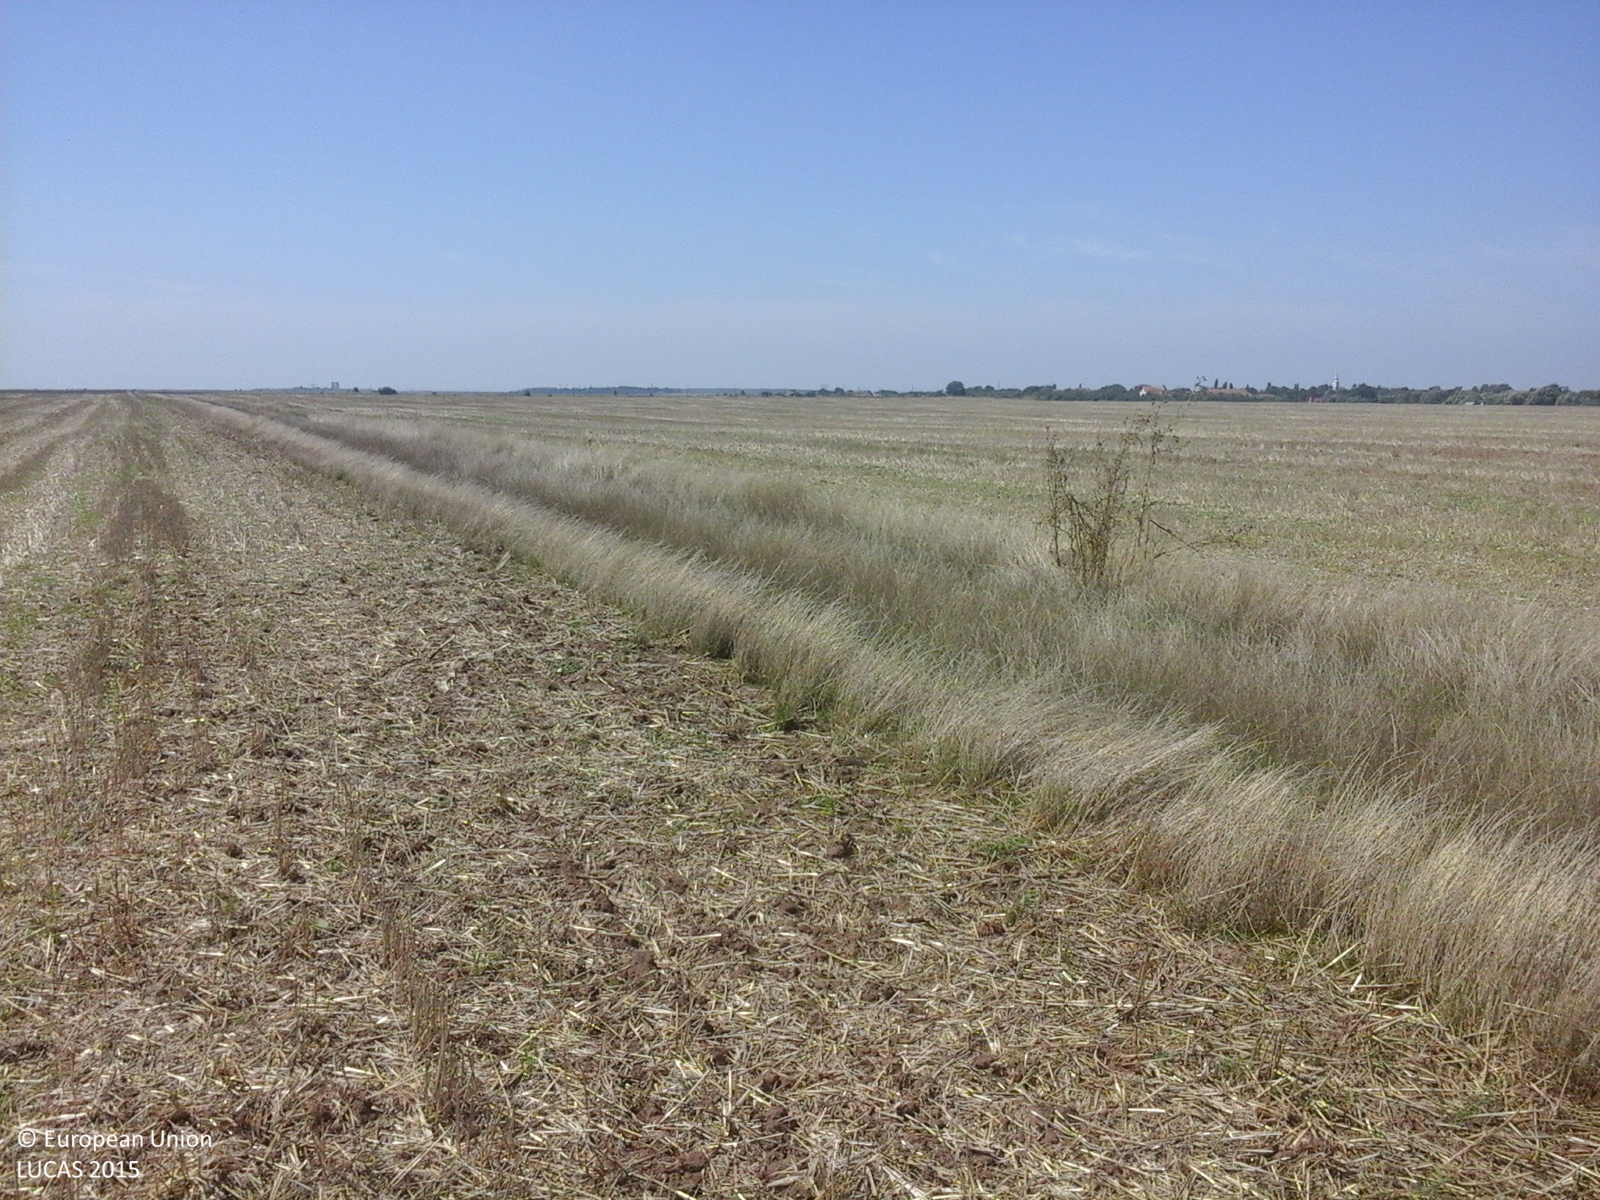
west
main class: Cropland
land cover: Common wheat
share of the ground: 50 - 75 %
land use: Agriculture (excluding fallow land and kitchen gardens)
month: August
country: RO
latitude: 45.9466
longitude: 21.1636
